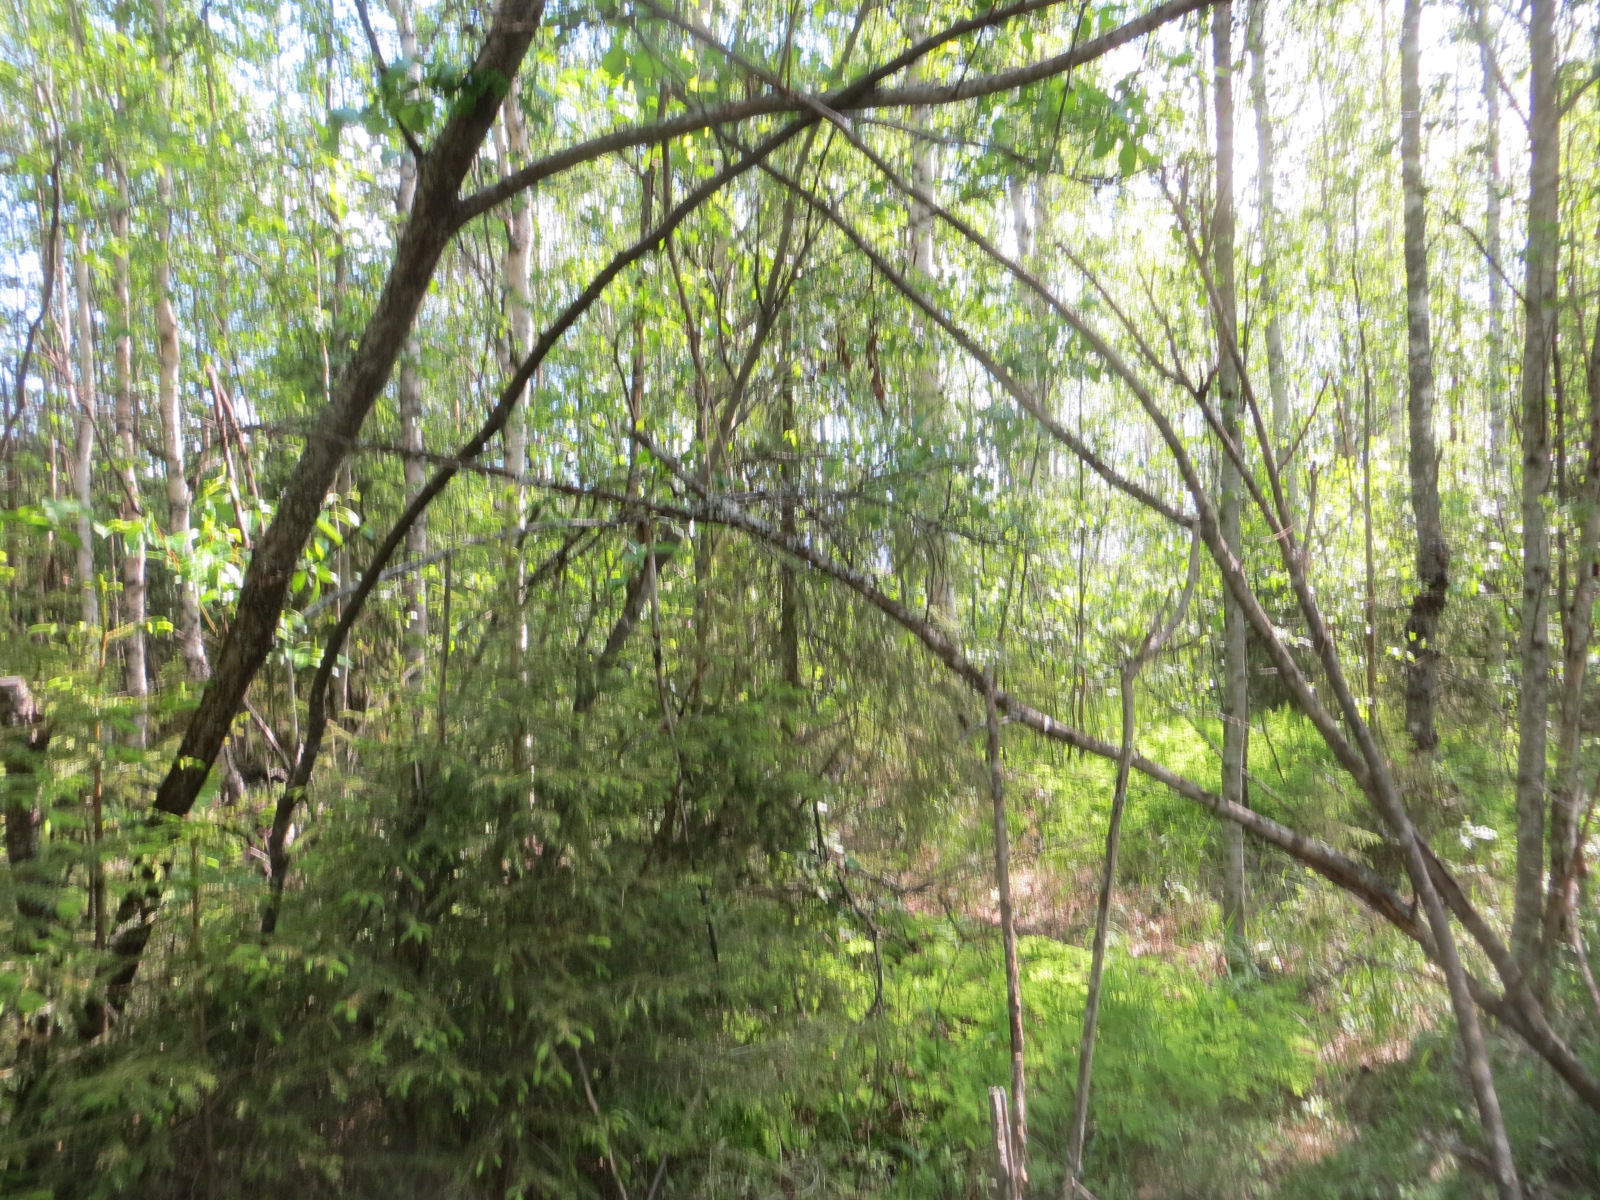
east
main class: Woodland
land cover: Other mixed woodland
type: boreal forest
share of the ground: > 75 %
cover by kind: broadleaved forest trees 45 %, coniferous forest trees 40 %, herbaceous plants 15 %
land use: Forestry
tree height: > 5 m
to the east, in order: Other mixed woodland; Ditches and canals; Pine dominated coniferous woodland; Pine dominated mixed woodland; Ditches and canals; Pine dominated mixed woodland; Artificial constructions in urban areas
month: June
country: FI
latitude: 66.5043
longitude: 25.6441
